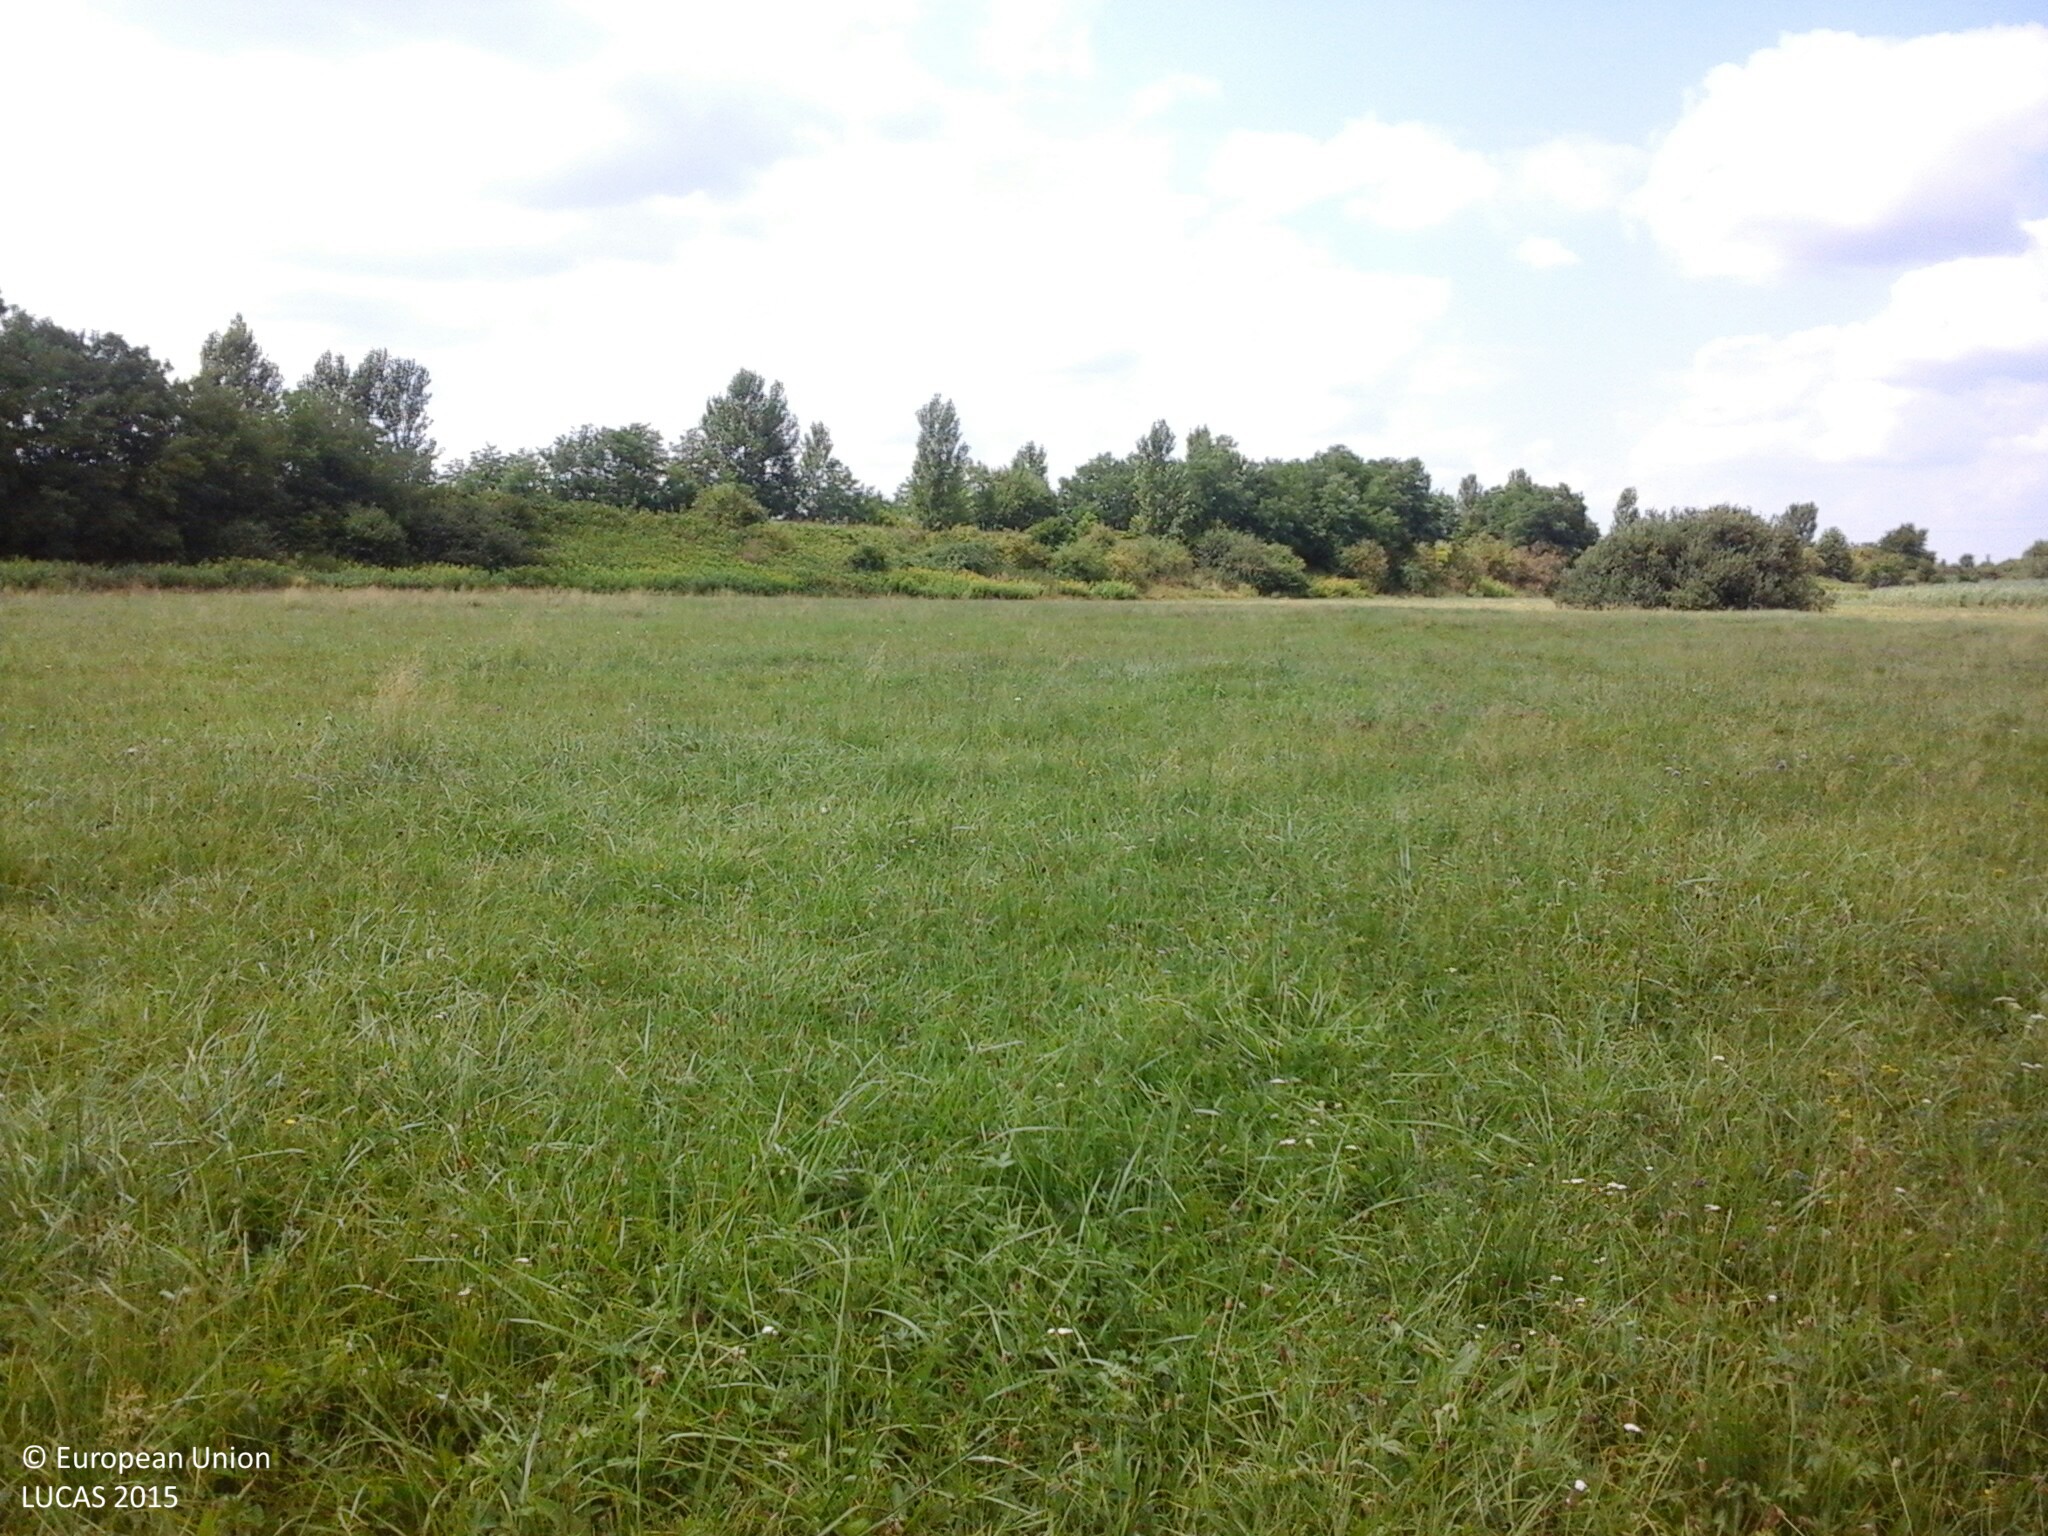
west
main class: Grassland
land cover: Grassland without tree/shrub cover
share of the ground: > 75 %
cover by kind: herbaceous plants 100 %
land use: Semi-natural and natural areas not in use
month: August
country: HU
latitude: 47.3565
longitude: 18.2066
